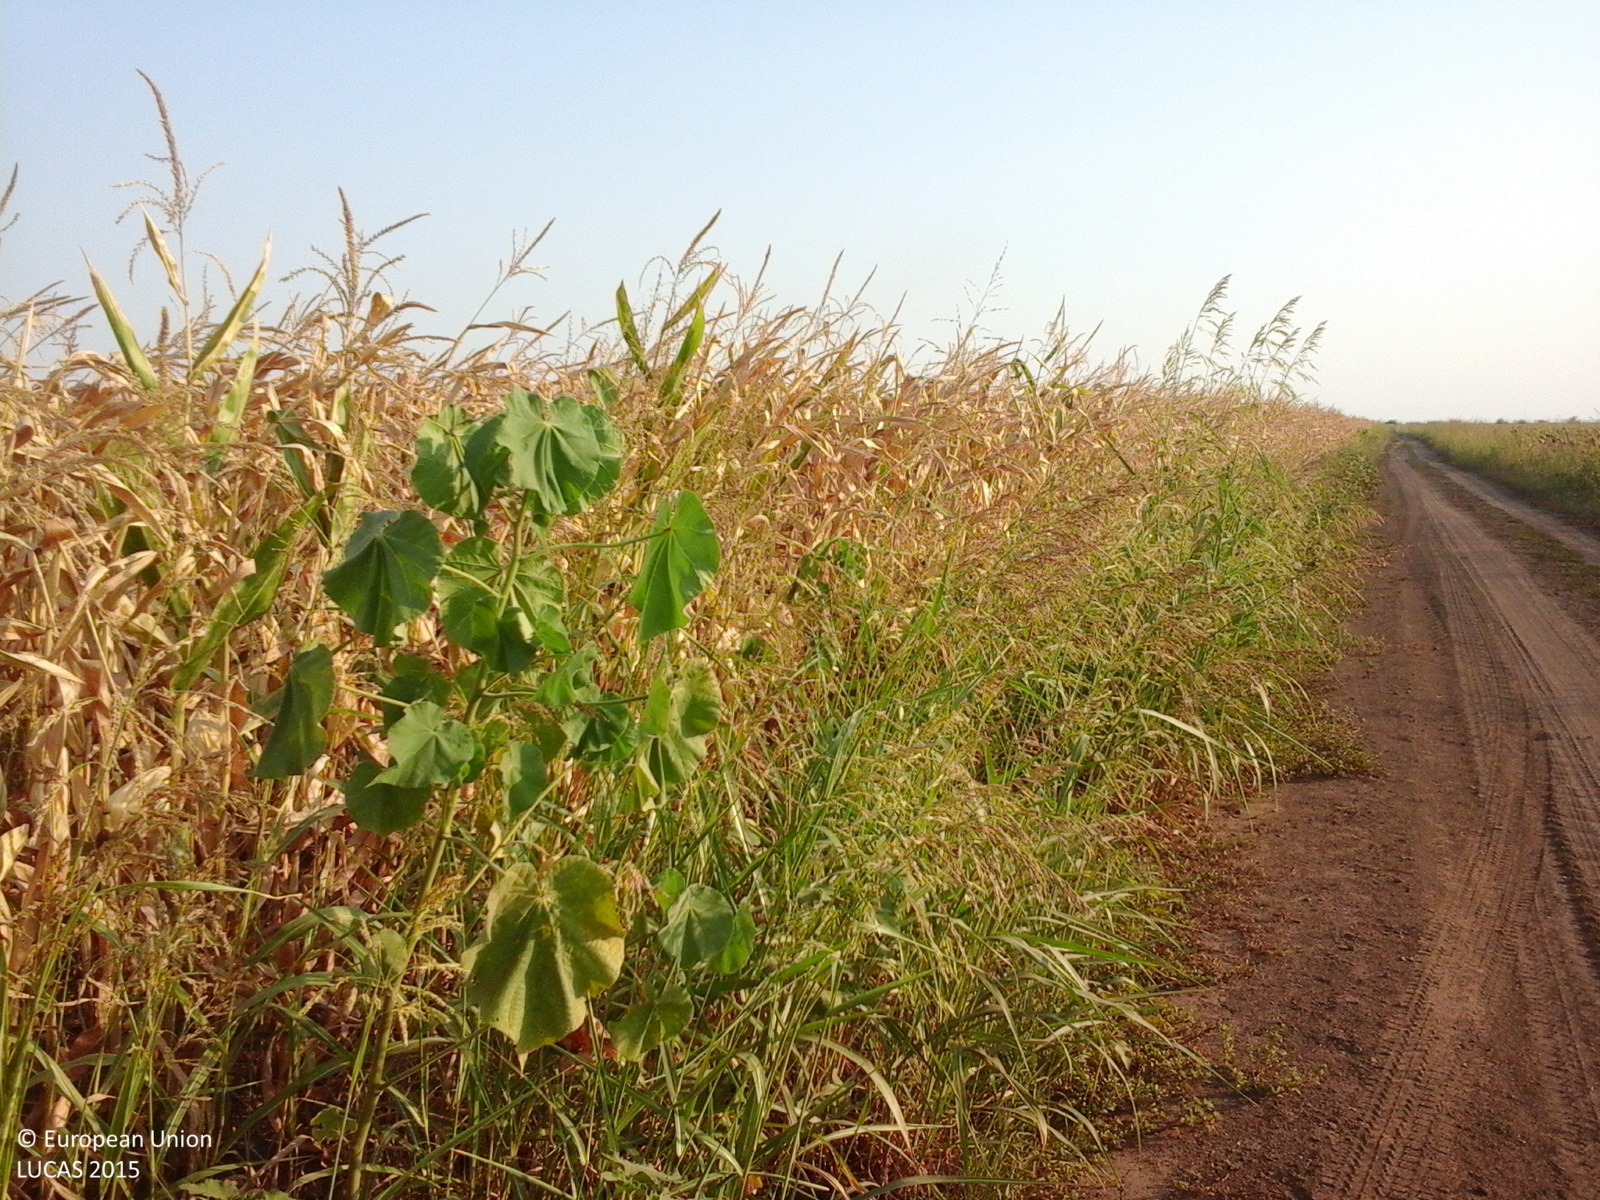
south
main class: Cropland
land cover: Maize
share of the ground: > 75 %
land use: Agriculture (excluding fallow land and kitchen gardens)
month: August
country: RO
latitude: 43.9783
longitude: 23.1962
